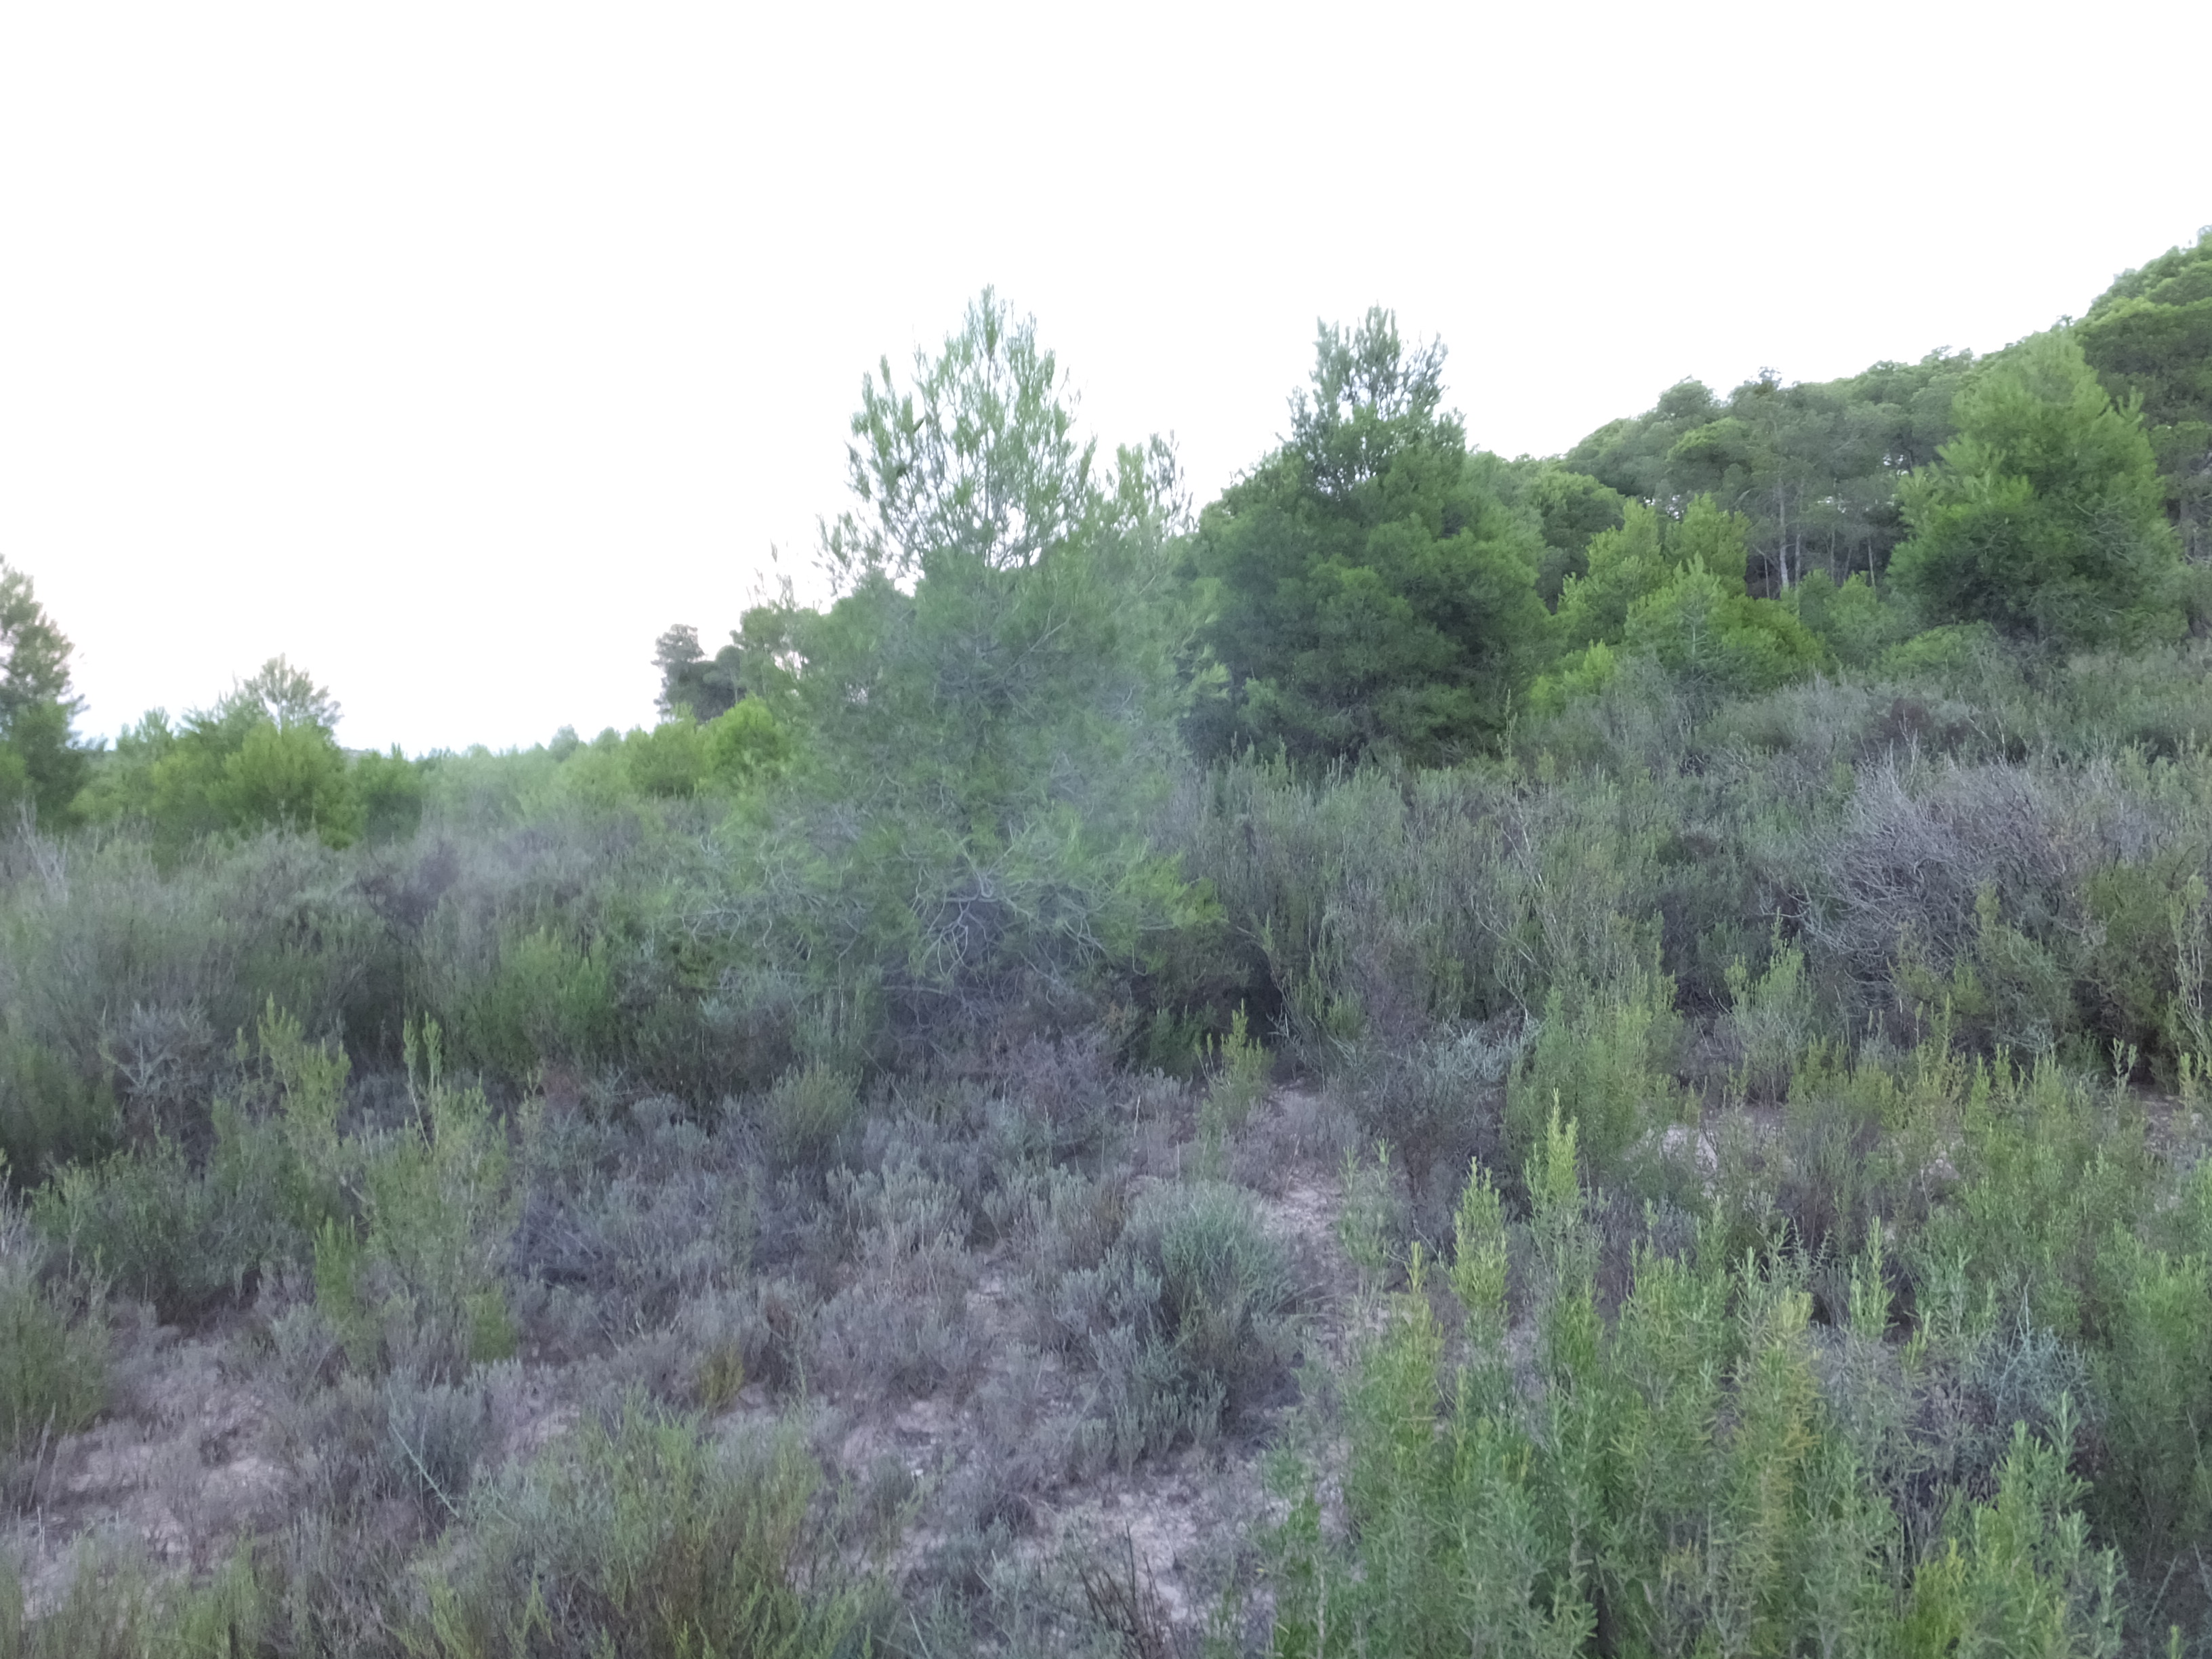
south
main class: Shrubland
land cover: Shrubland with sparse tree cover
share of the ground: > 75 %
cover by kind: shrubs 75 %, herbaceous plants 20 %, coniferous forest trees 5 %
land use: Abandoned areas
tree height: < 5 m
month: August
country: ES
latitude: 41.3568
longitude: 0.1740
